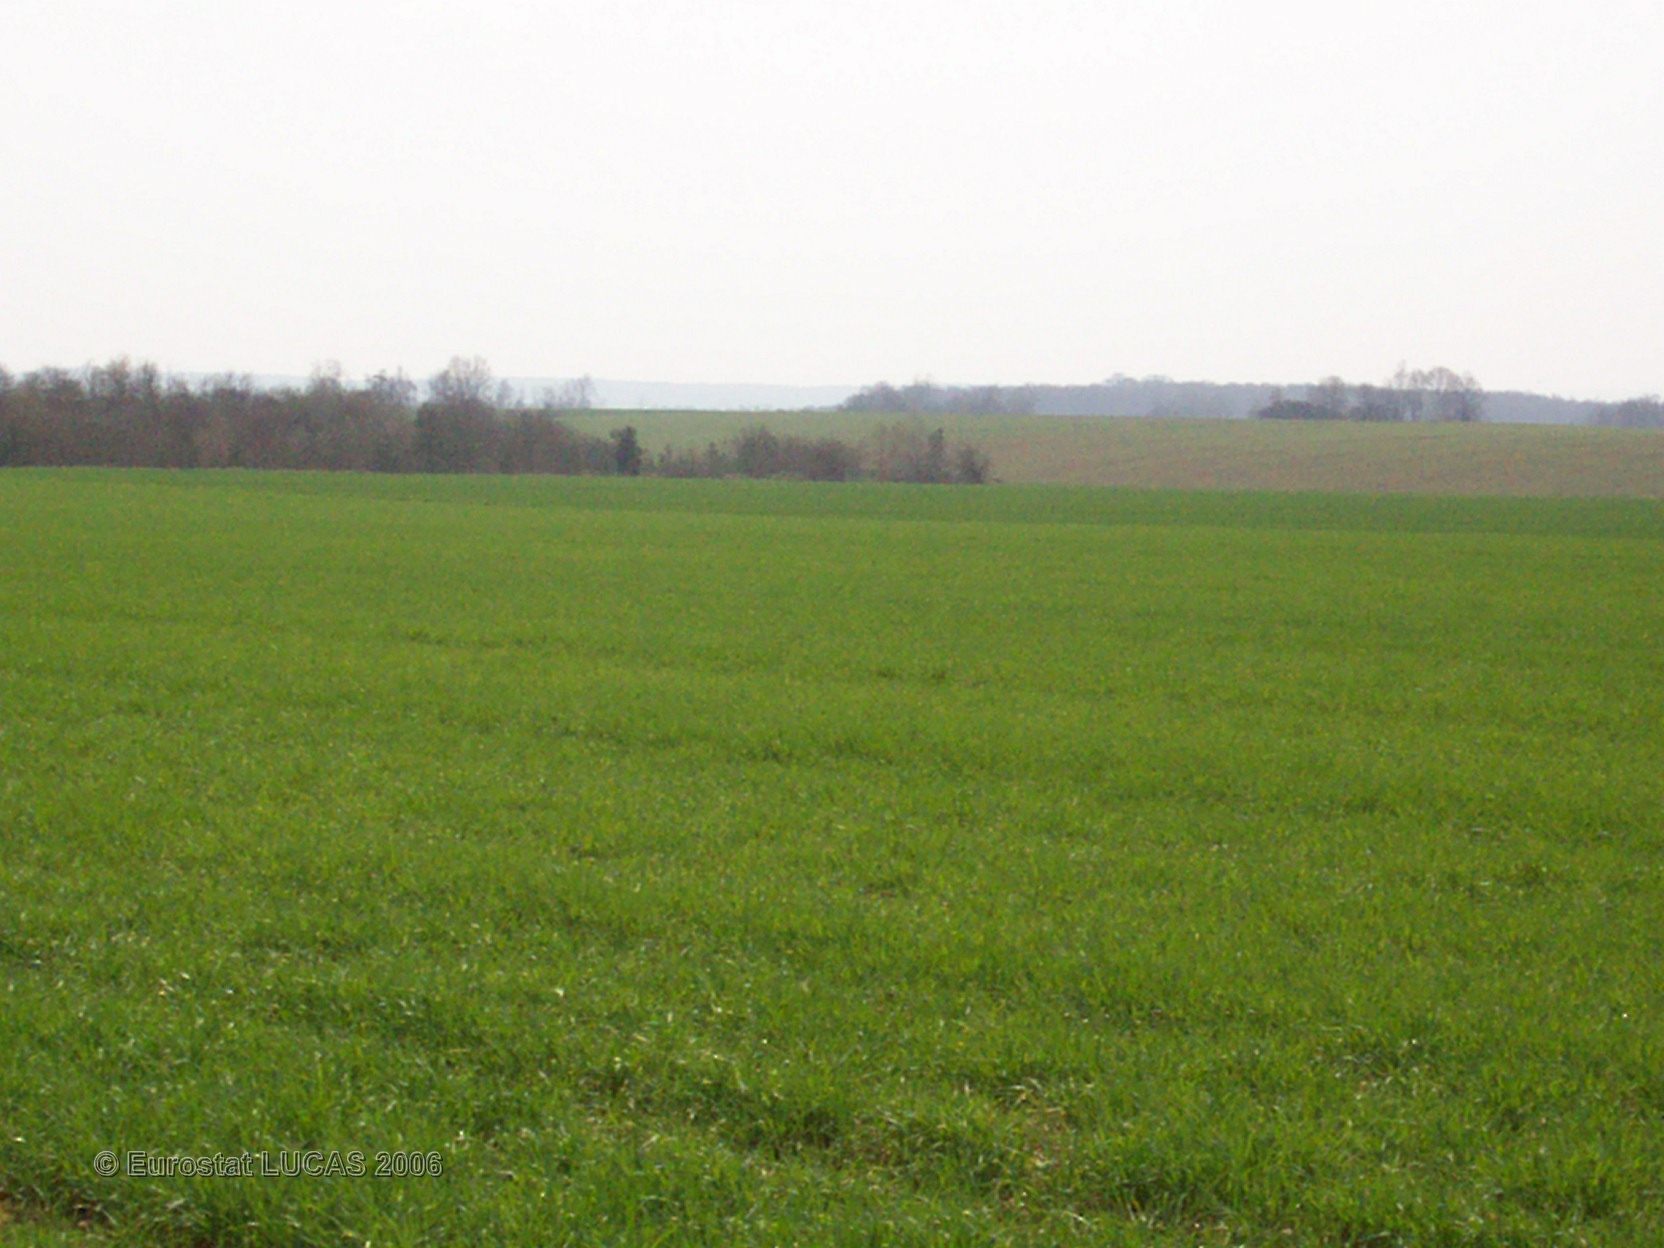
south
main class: Cropland
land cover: Barley
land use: Agriculture (excluding fallow land and kitchen gardens)
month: April
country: FR
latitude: 48.7441
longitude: 5.9608
